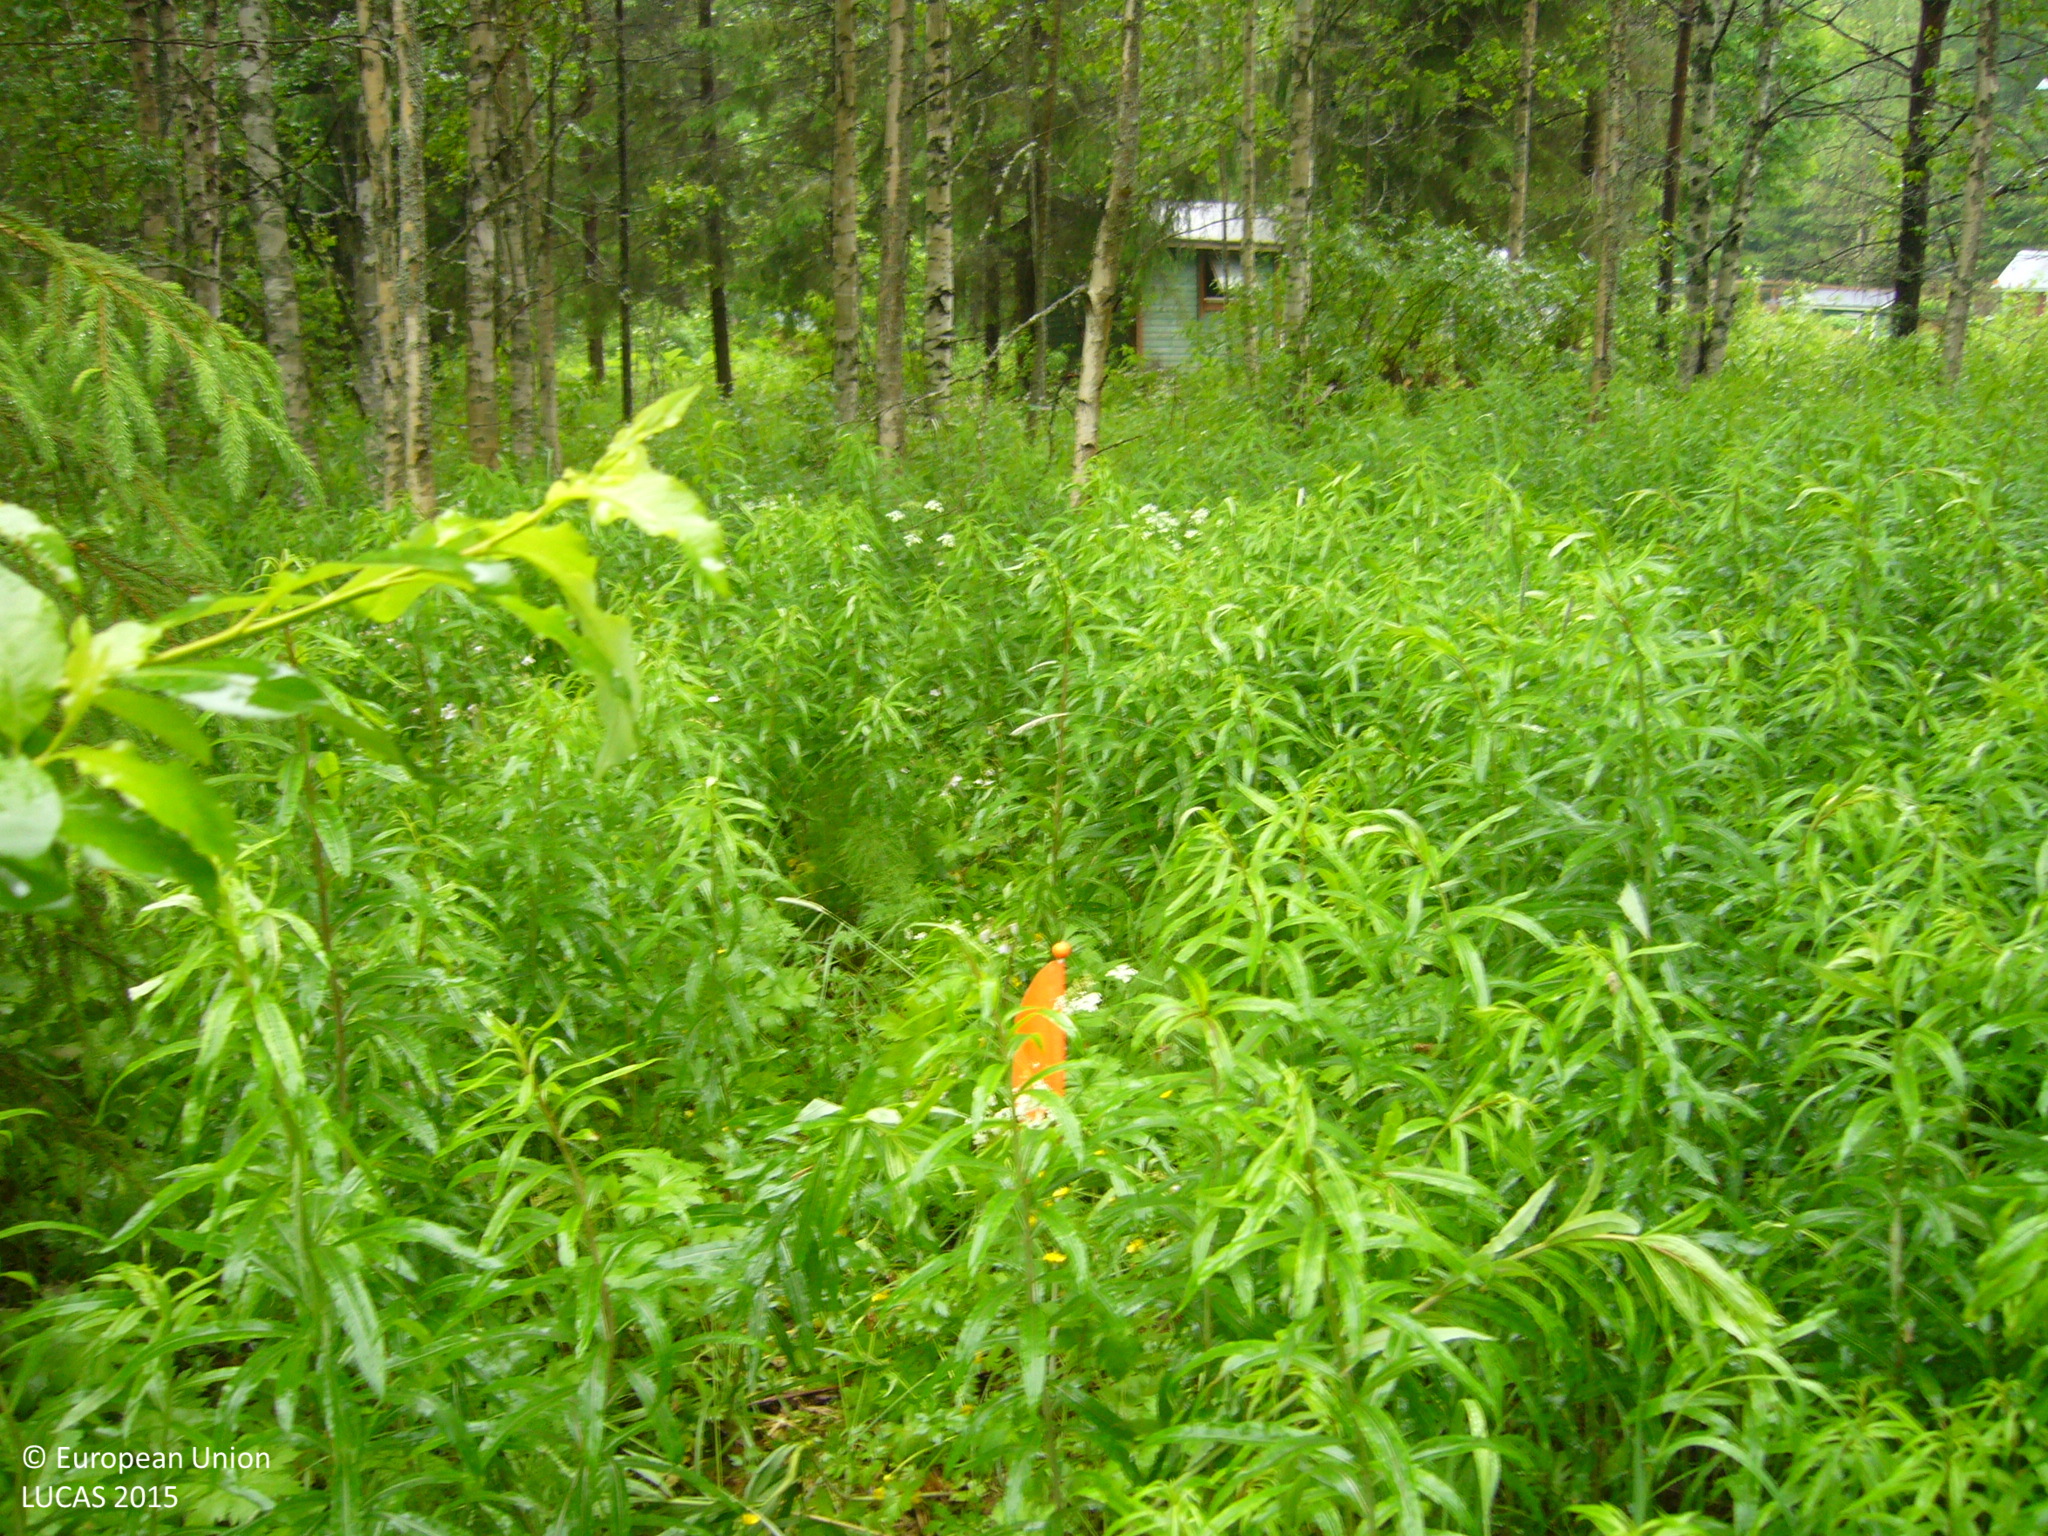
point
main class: Woodland
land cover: Other mixed woodland
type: boreal forest
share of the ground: > 75 %
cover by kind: broadleaved forest trees 50 %, coniferous forest trees 30 %, shrubs 20 %
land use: Forestry
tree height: > 5 m
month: June
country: FI
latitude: 63.6610
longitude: 26.0935
